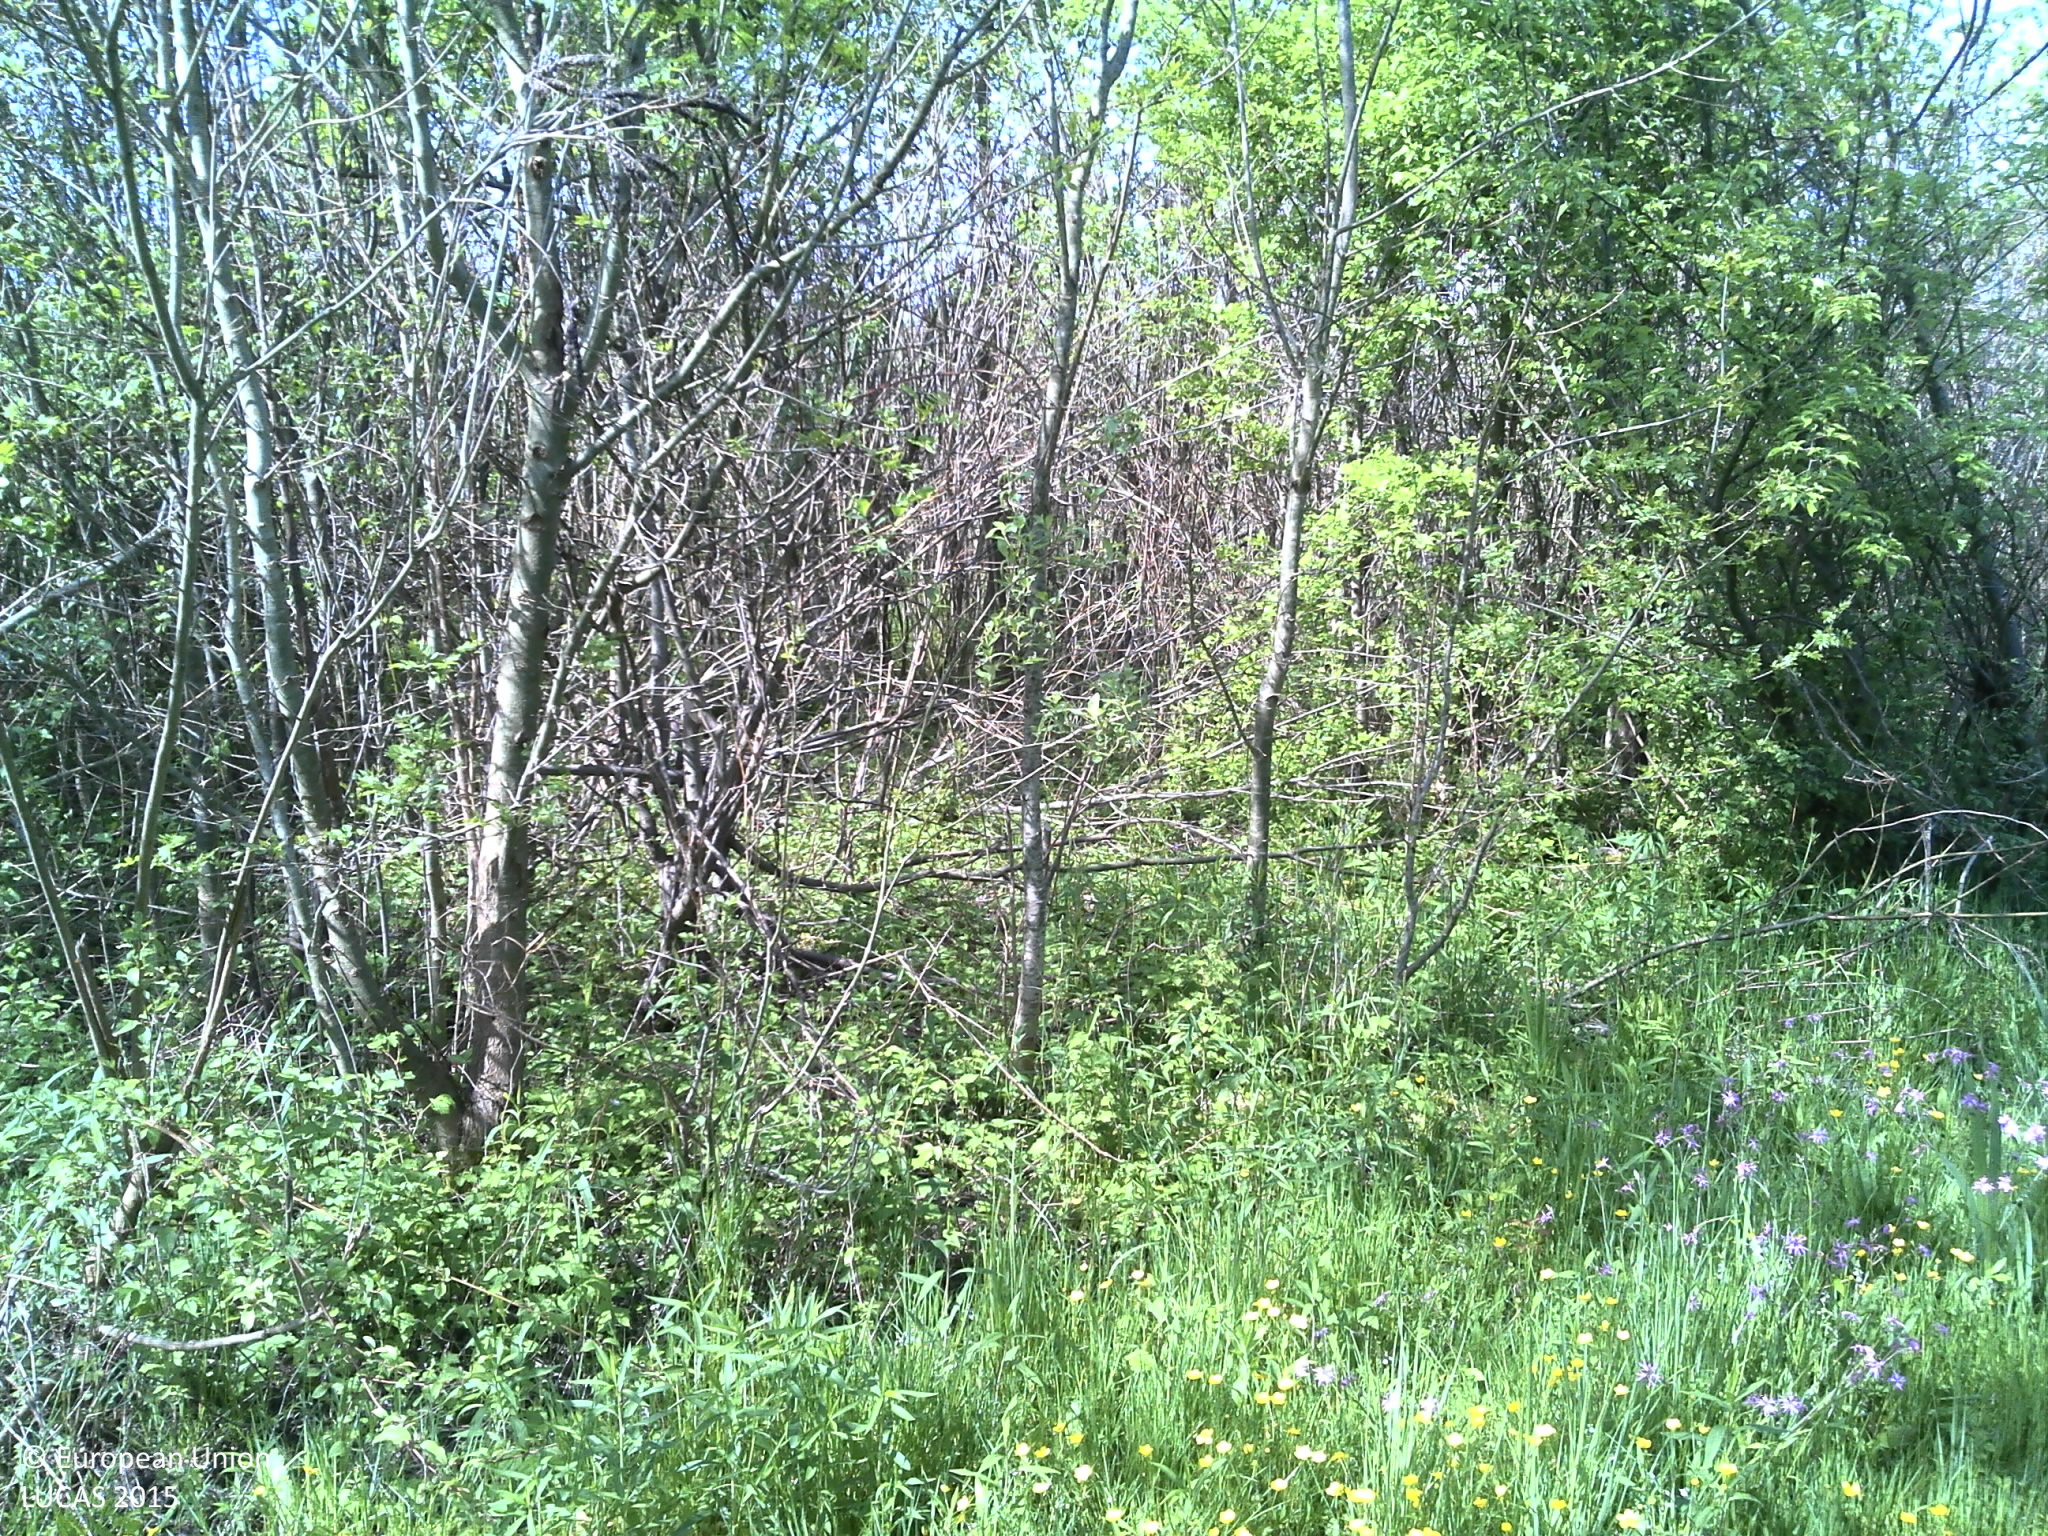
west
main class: Woodland
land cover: Broadleaved woodland
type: mesophytic deciduous forest
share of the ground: > 75 %
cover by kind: broadleaved forest trees 80 %, herbaceous plants 20 %
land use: Forestry
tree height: > 5 m
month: May
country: HR
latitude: 45.2177
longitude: 18.4732
